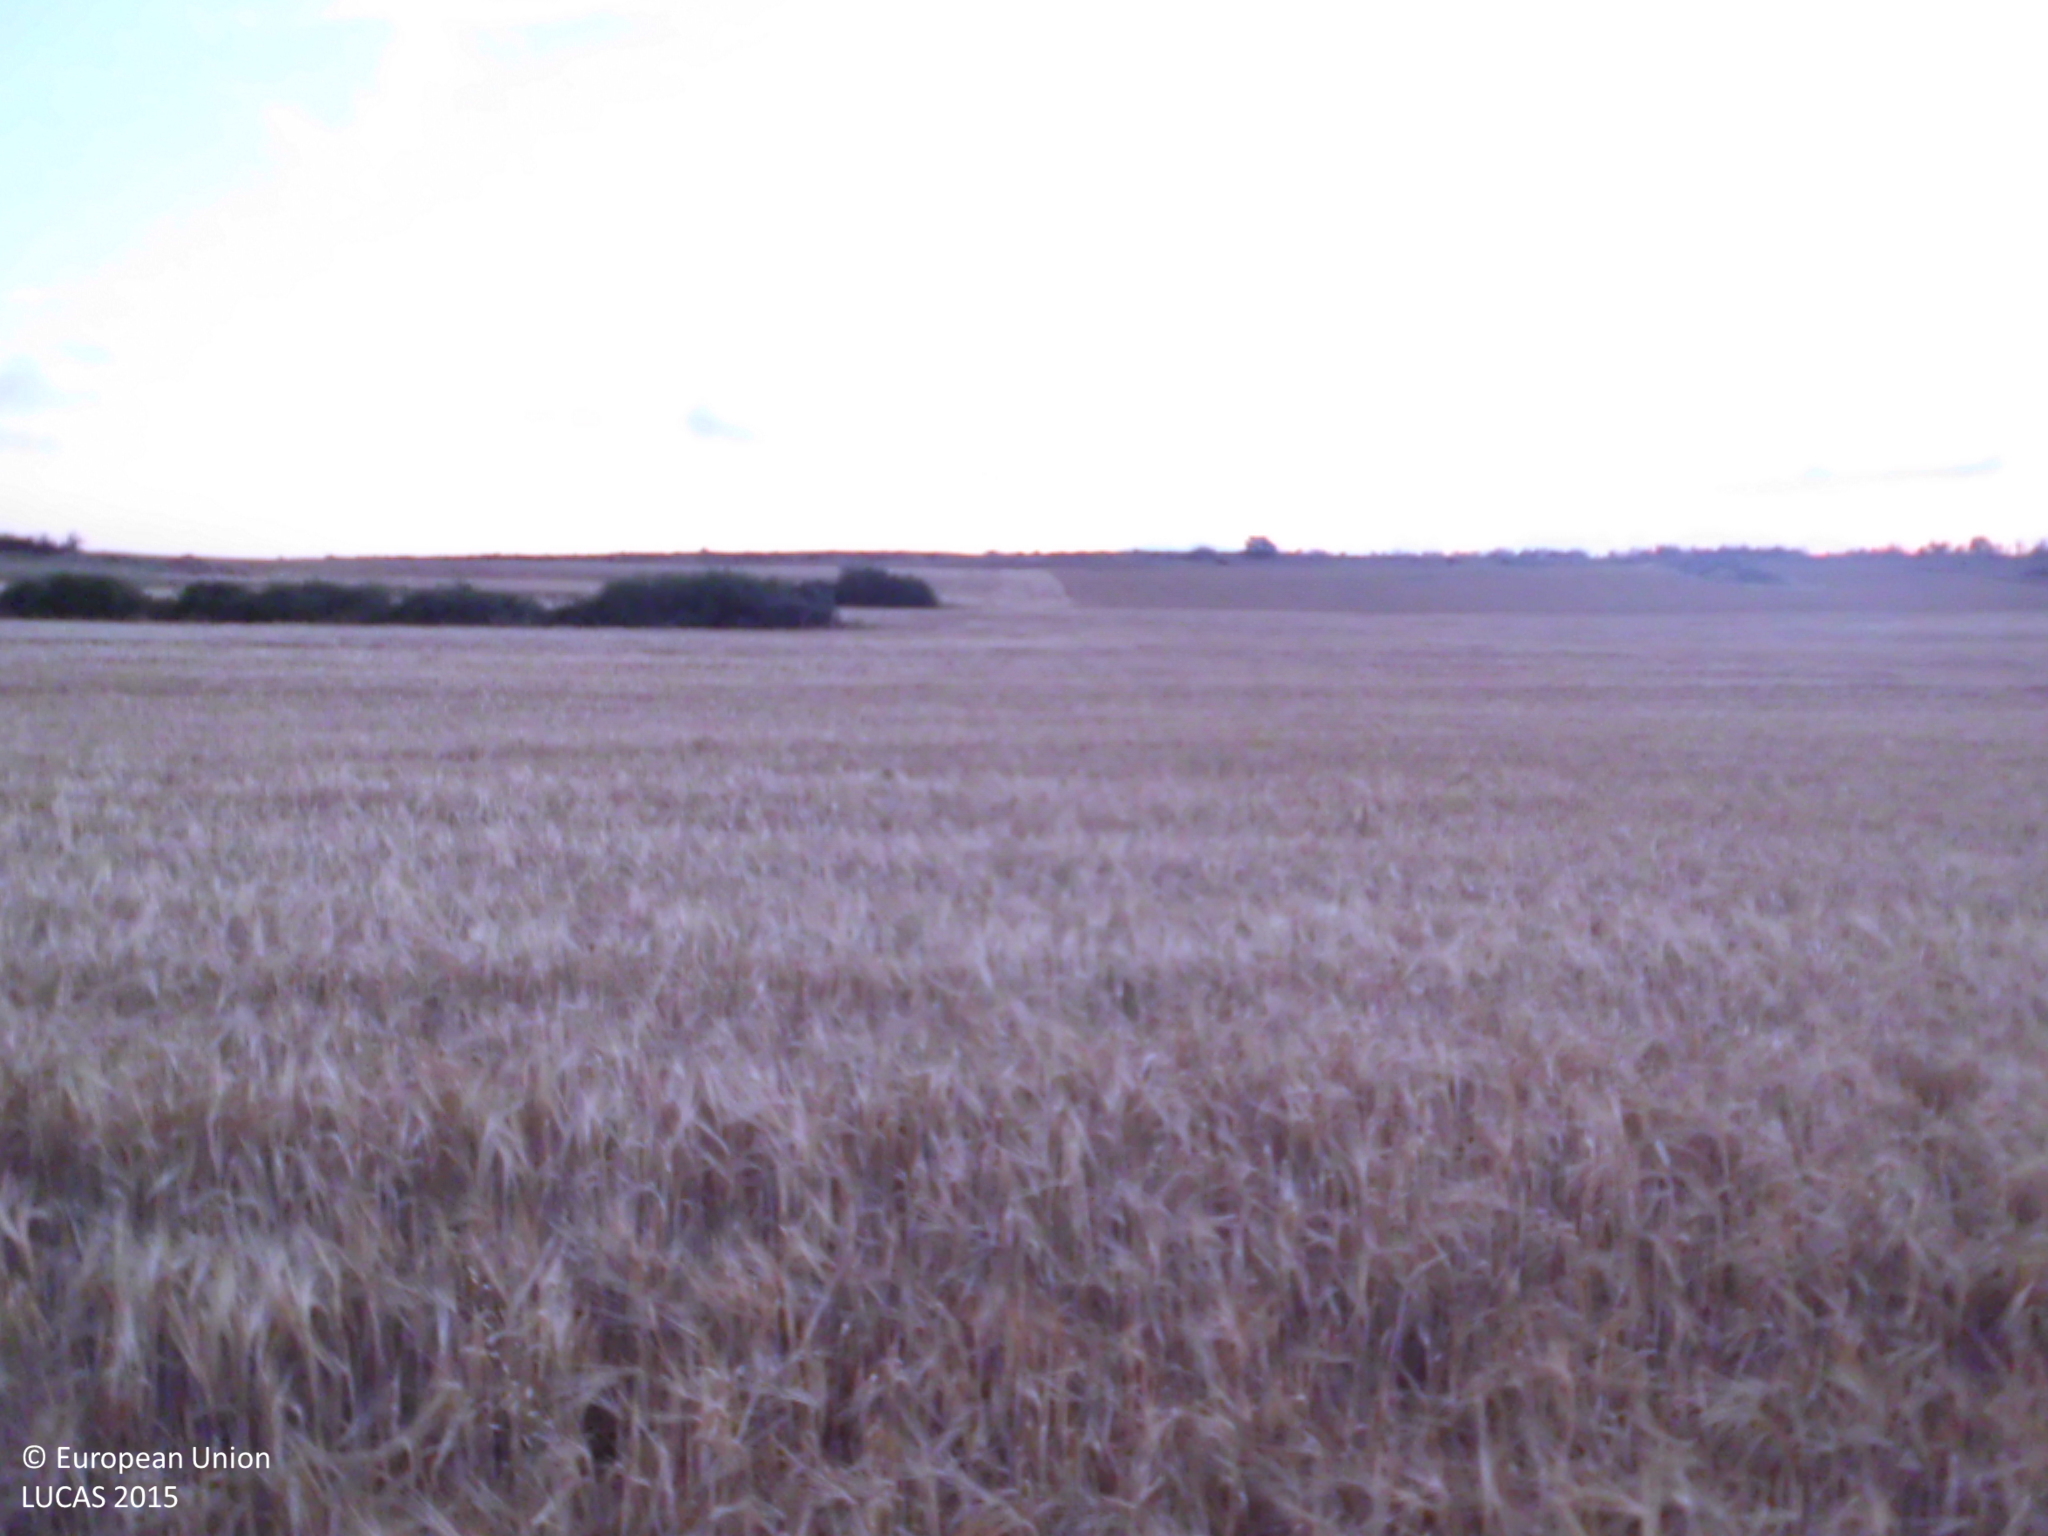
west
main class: Cropland
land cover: Barley
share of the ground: > 75 %
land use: Agriculture (excluding fallow land and kitchen gardens)
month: July
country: ES
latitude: 42.7526
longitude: -4.2838
